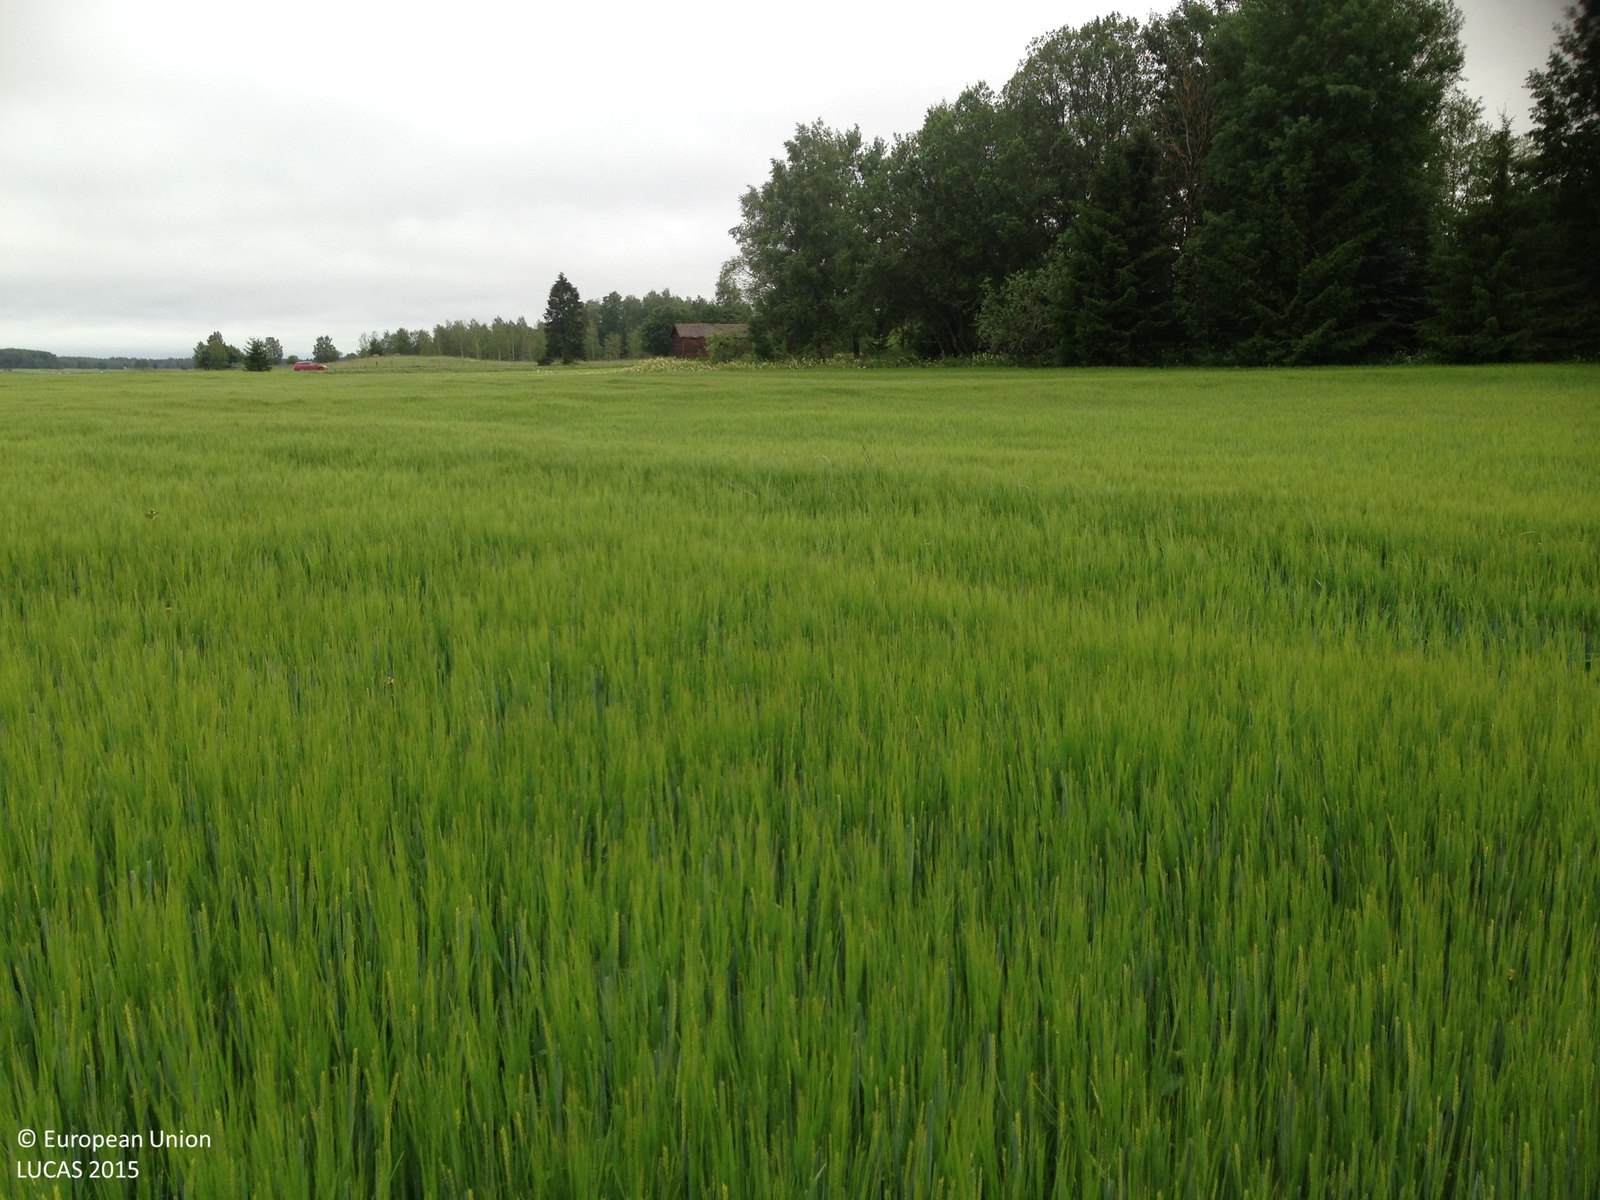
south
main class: Cropland
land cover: Barley
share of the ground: > 75 %
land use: Agriculture (excluding fallow land and kitchen gardens)
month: July
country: SE
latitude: 59.9010
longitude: 16.9460
